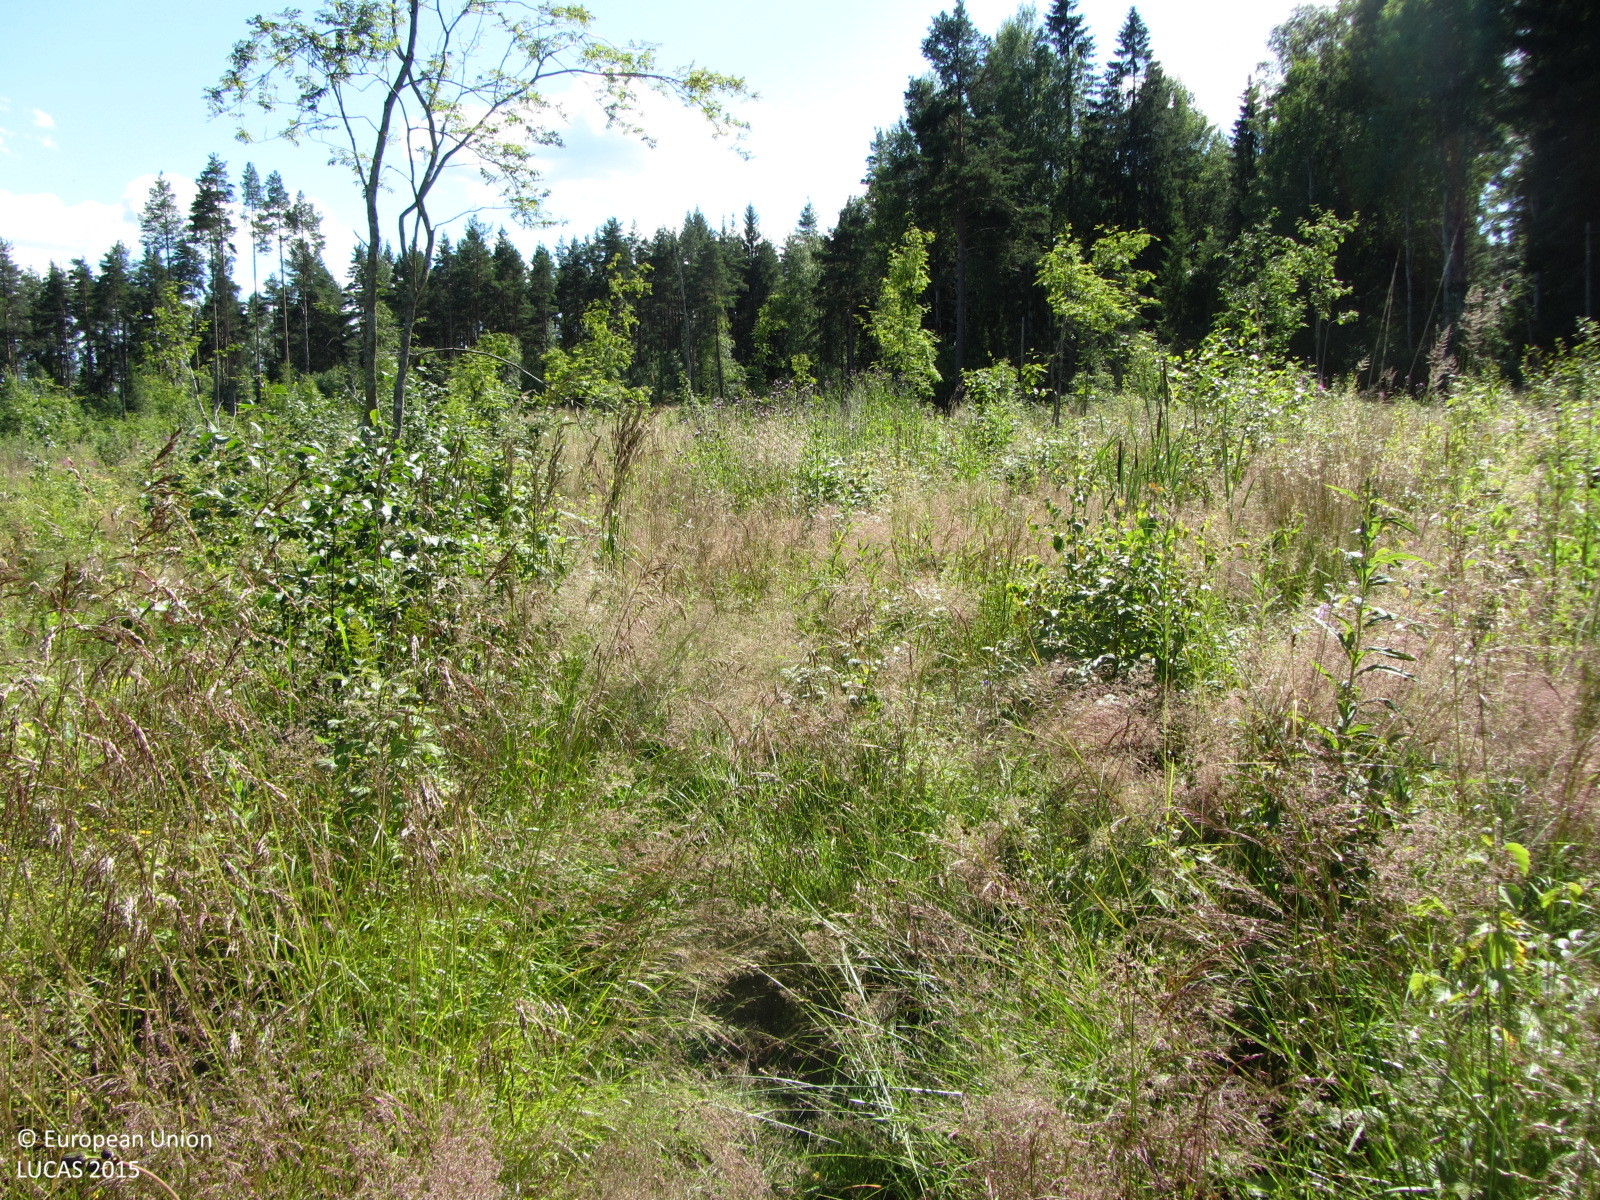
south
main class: Woodland
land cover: Broadleaved woodland
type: hemiboreal forest and nemoral coniferous forest and mixed broadleaved-coniferous forest
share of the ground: 10 - 25 %
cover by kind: herbaceous plants 90 %, broadleaved forest trees 10 %
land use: Forestry
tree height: < 5 m
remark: Nursery
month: July
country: FI
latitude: 61.1072
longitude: 25.6195
